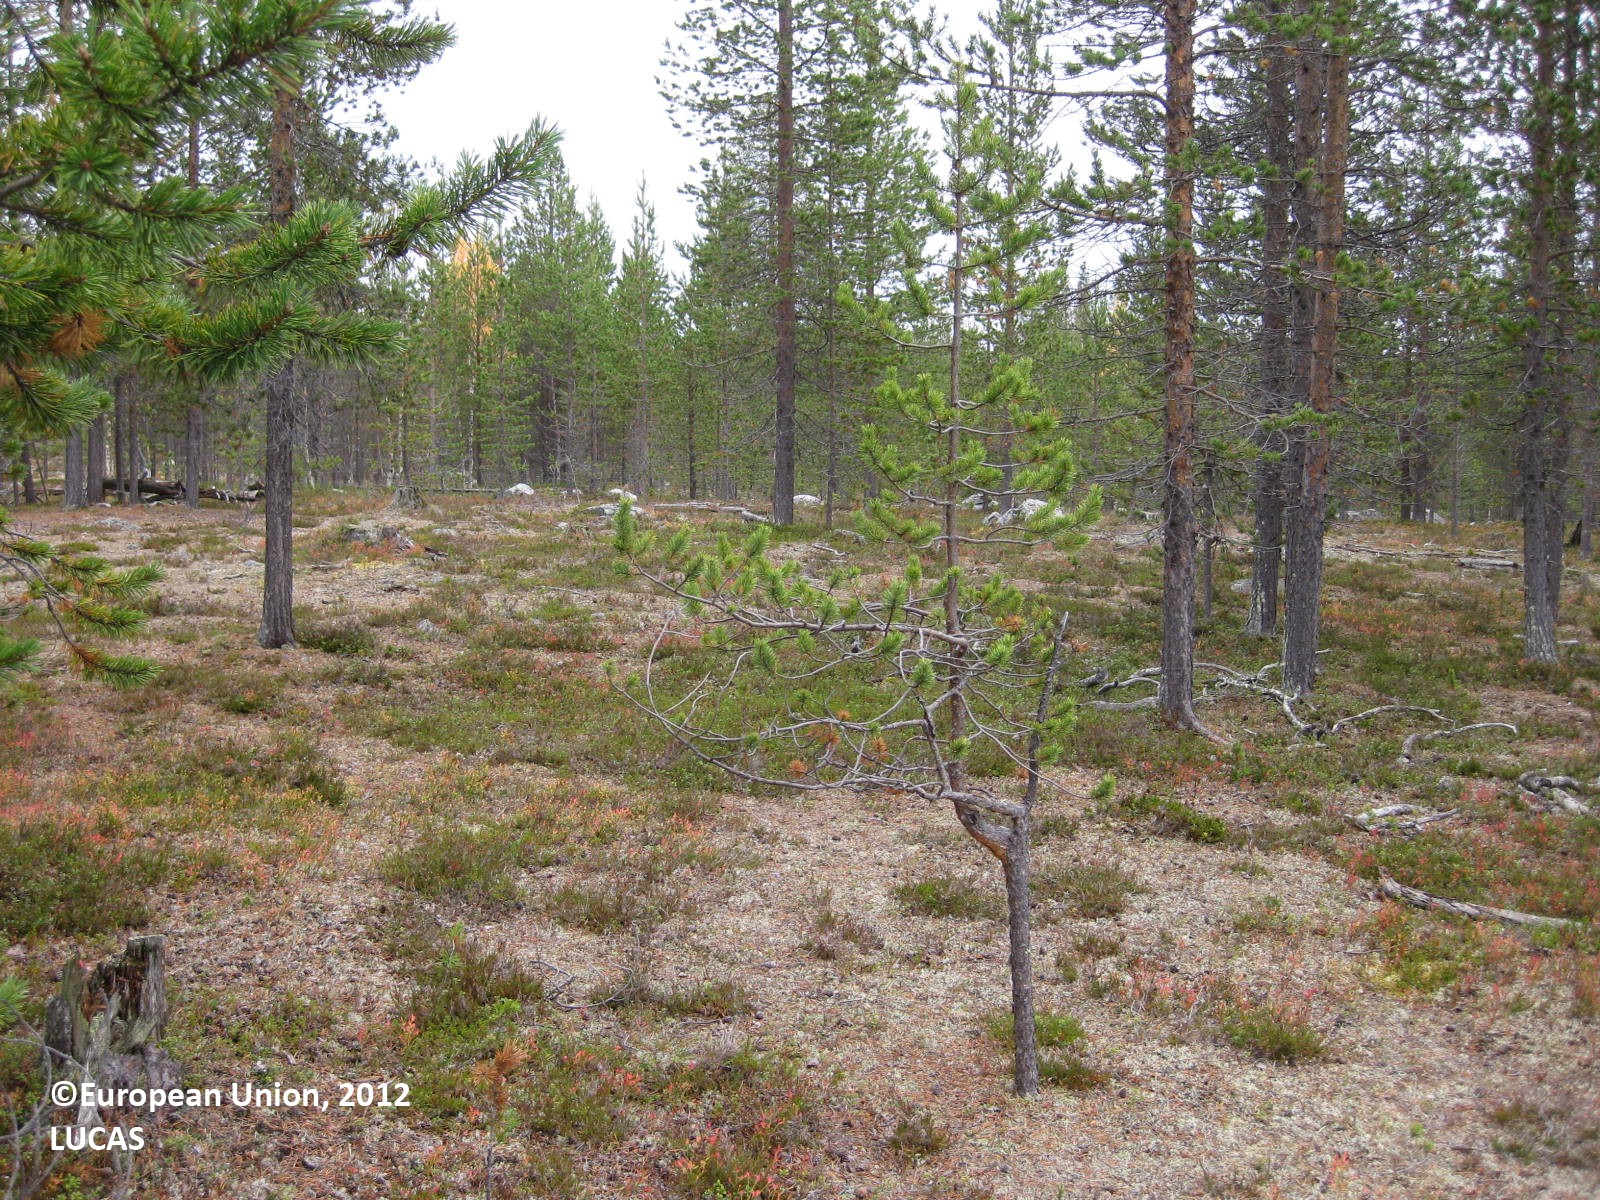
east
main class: Woodland
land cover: Pine dominated coniferous woodland
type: boreal forest
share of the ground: 50 - 75 %
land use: Forestry
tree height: > 5 m
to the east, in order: Pine dominated coniferous woodland; Tracks; Pine dominated coniferous woodland
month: September
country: FI
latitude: 68.0933
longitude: 23.7247
